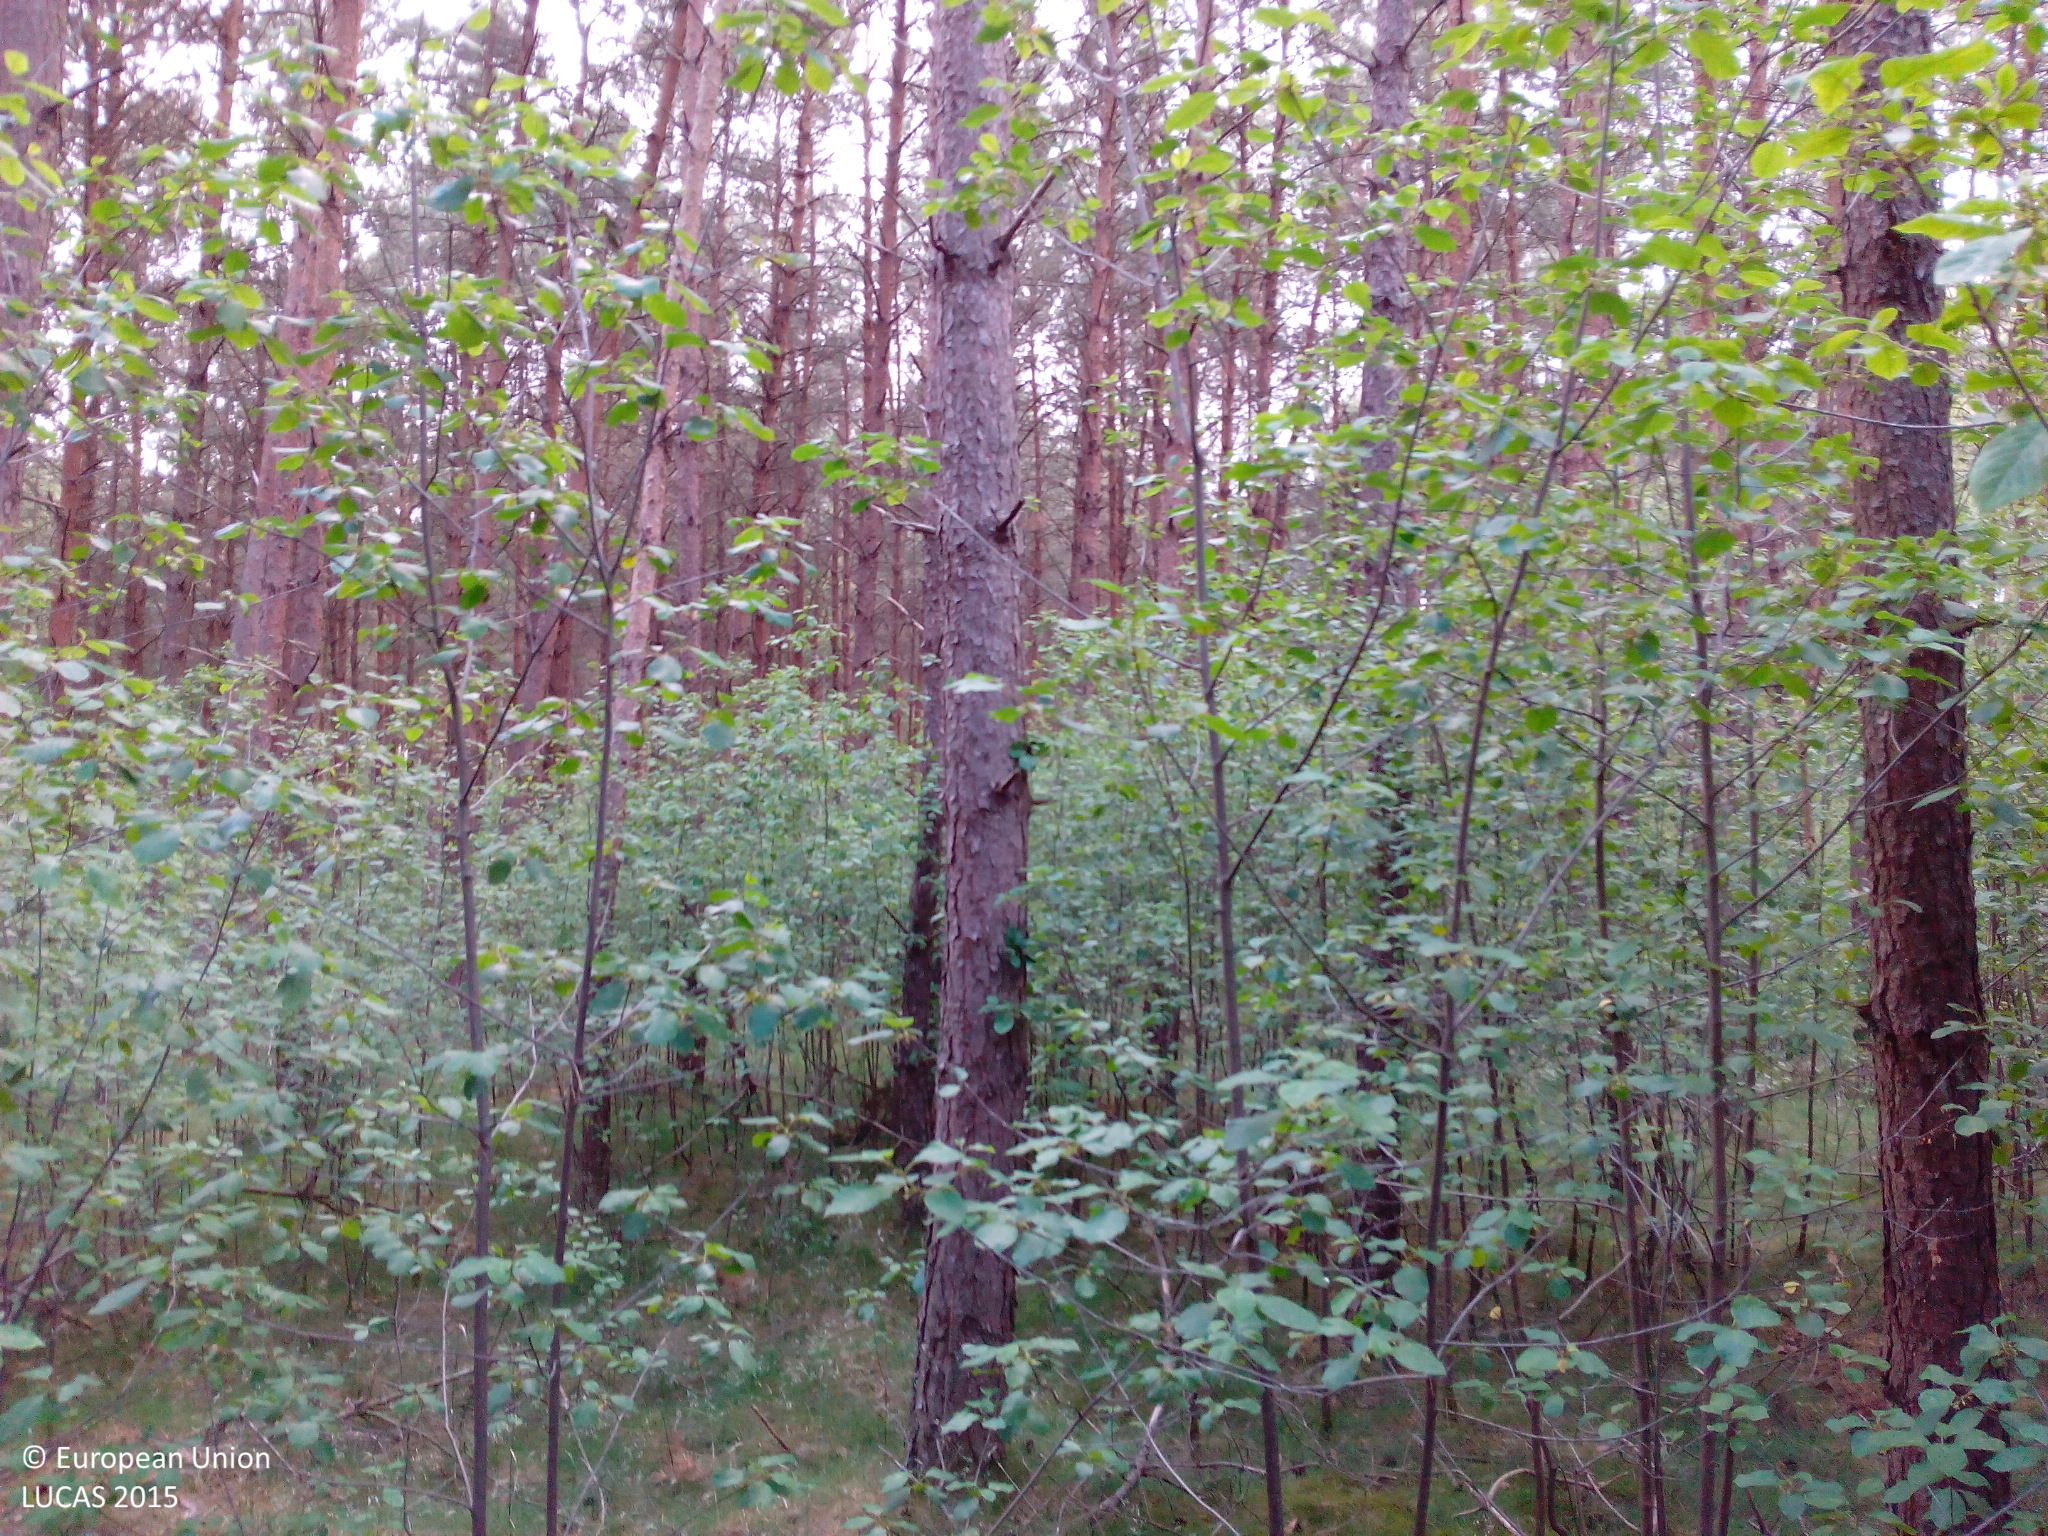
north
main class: Woodland
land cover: Pine dominated coniferous woodland
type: hemiboreal forest and nemoral coniferous forest and mixed broadleaved-coniferous forest
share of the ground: 50 - 75 %
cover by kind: coniferous forest trees 70 %, shrubs 15 %, herbaceous plants 10 %, broadleaved forest trees 5 %
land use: Forestry
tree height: > 5 m
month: June
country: DE
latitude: 52.6371
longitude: 7.4145
